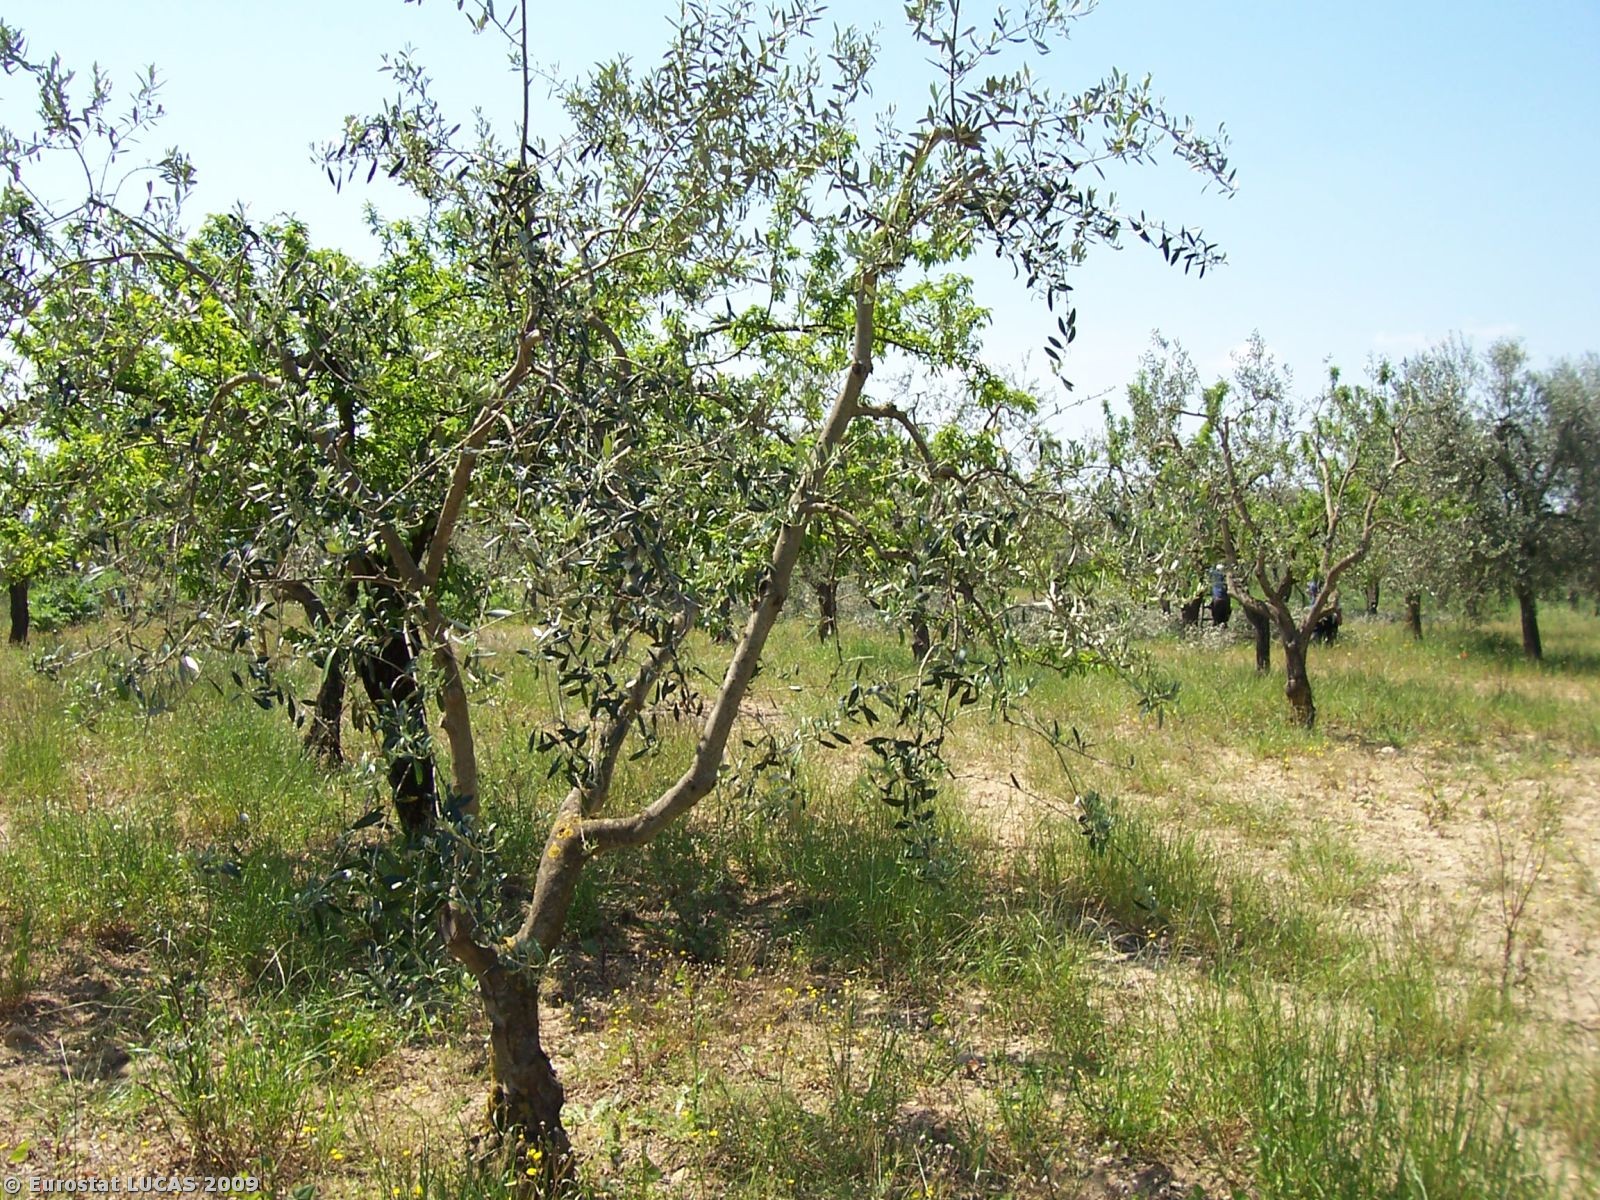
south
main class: Cropland
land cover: Olive groves
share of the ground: 50 - 75 %
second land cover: Spontaneously vegetated surfaces
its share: > 75 %
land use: Agriculture (excluding fallow land and kitchen gardens)
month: May
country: IT
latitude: 40.6566
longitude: 16.9430
